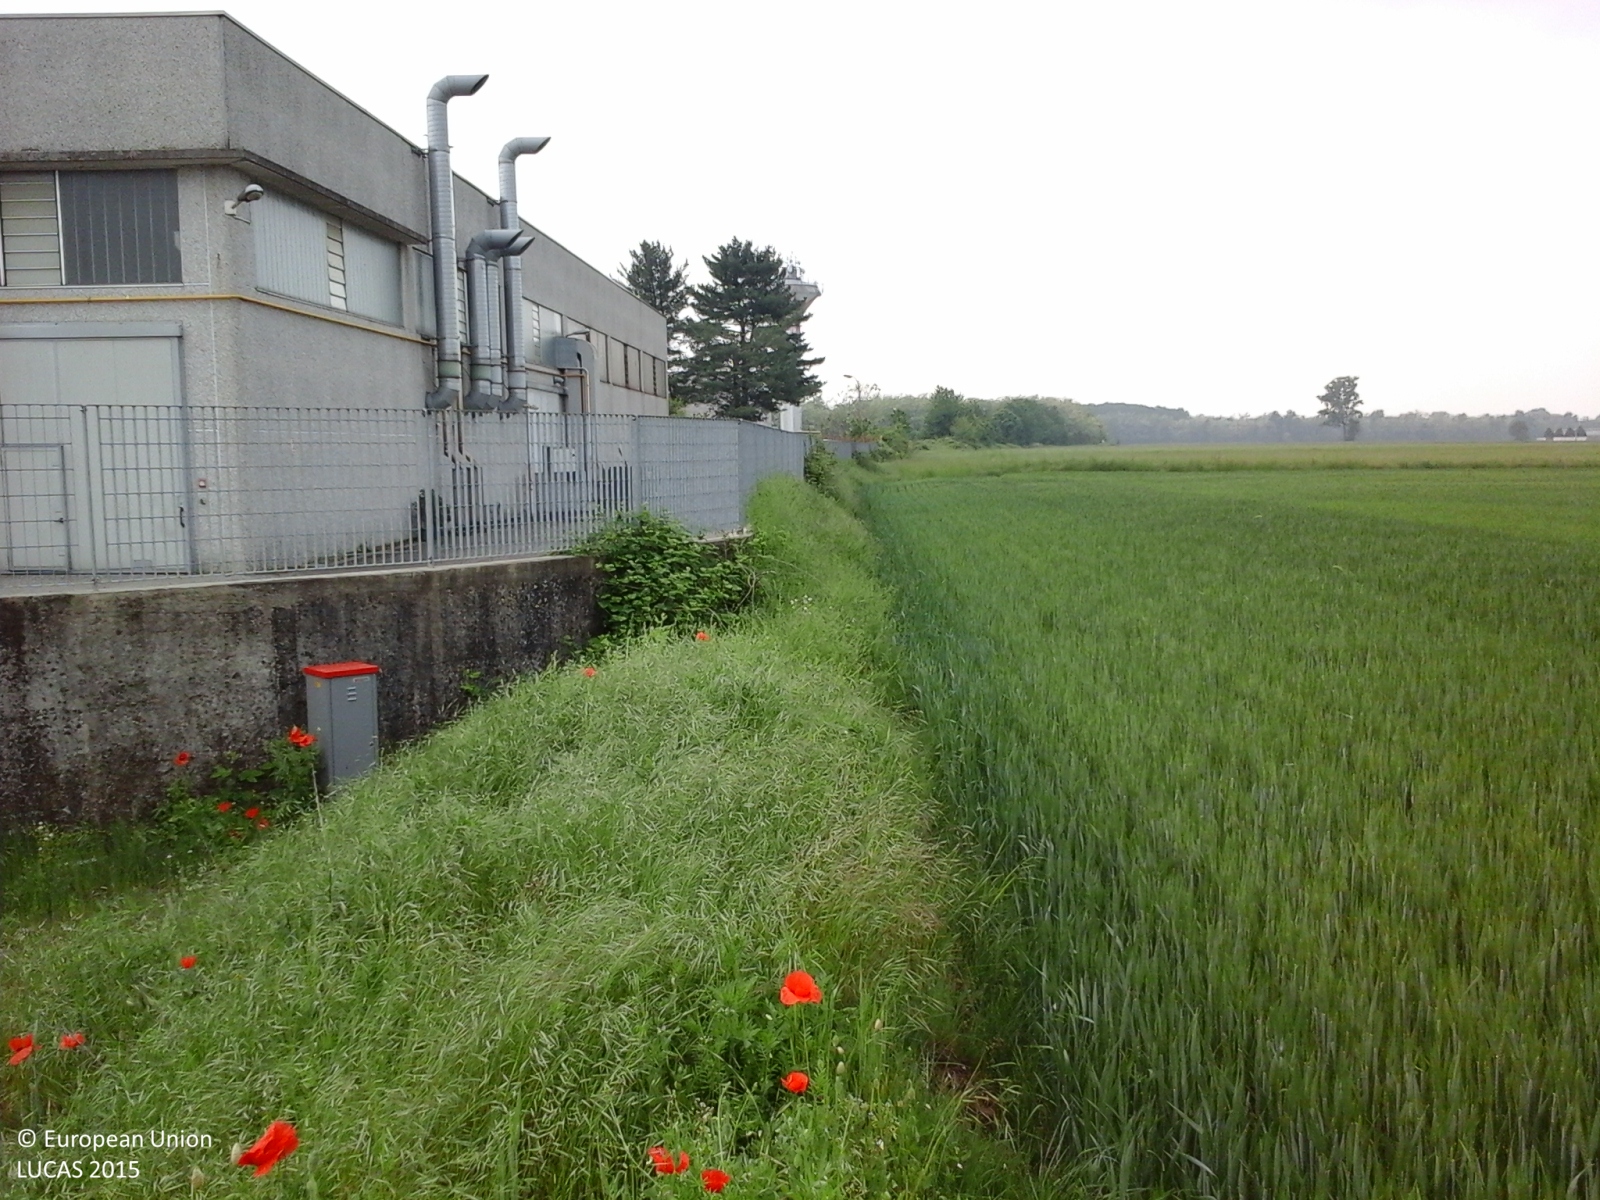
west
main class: Cropland
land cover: Common wheat
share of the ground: > 75 %
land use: Agriculture (excluding fallow land and kitchen gardens)
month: May
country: IT
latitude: 45.5309
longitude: 8.5810
